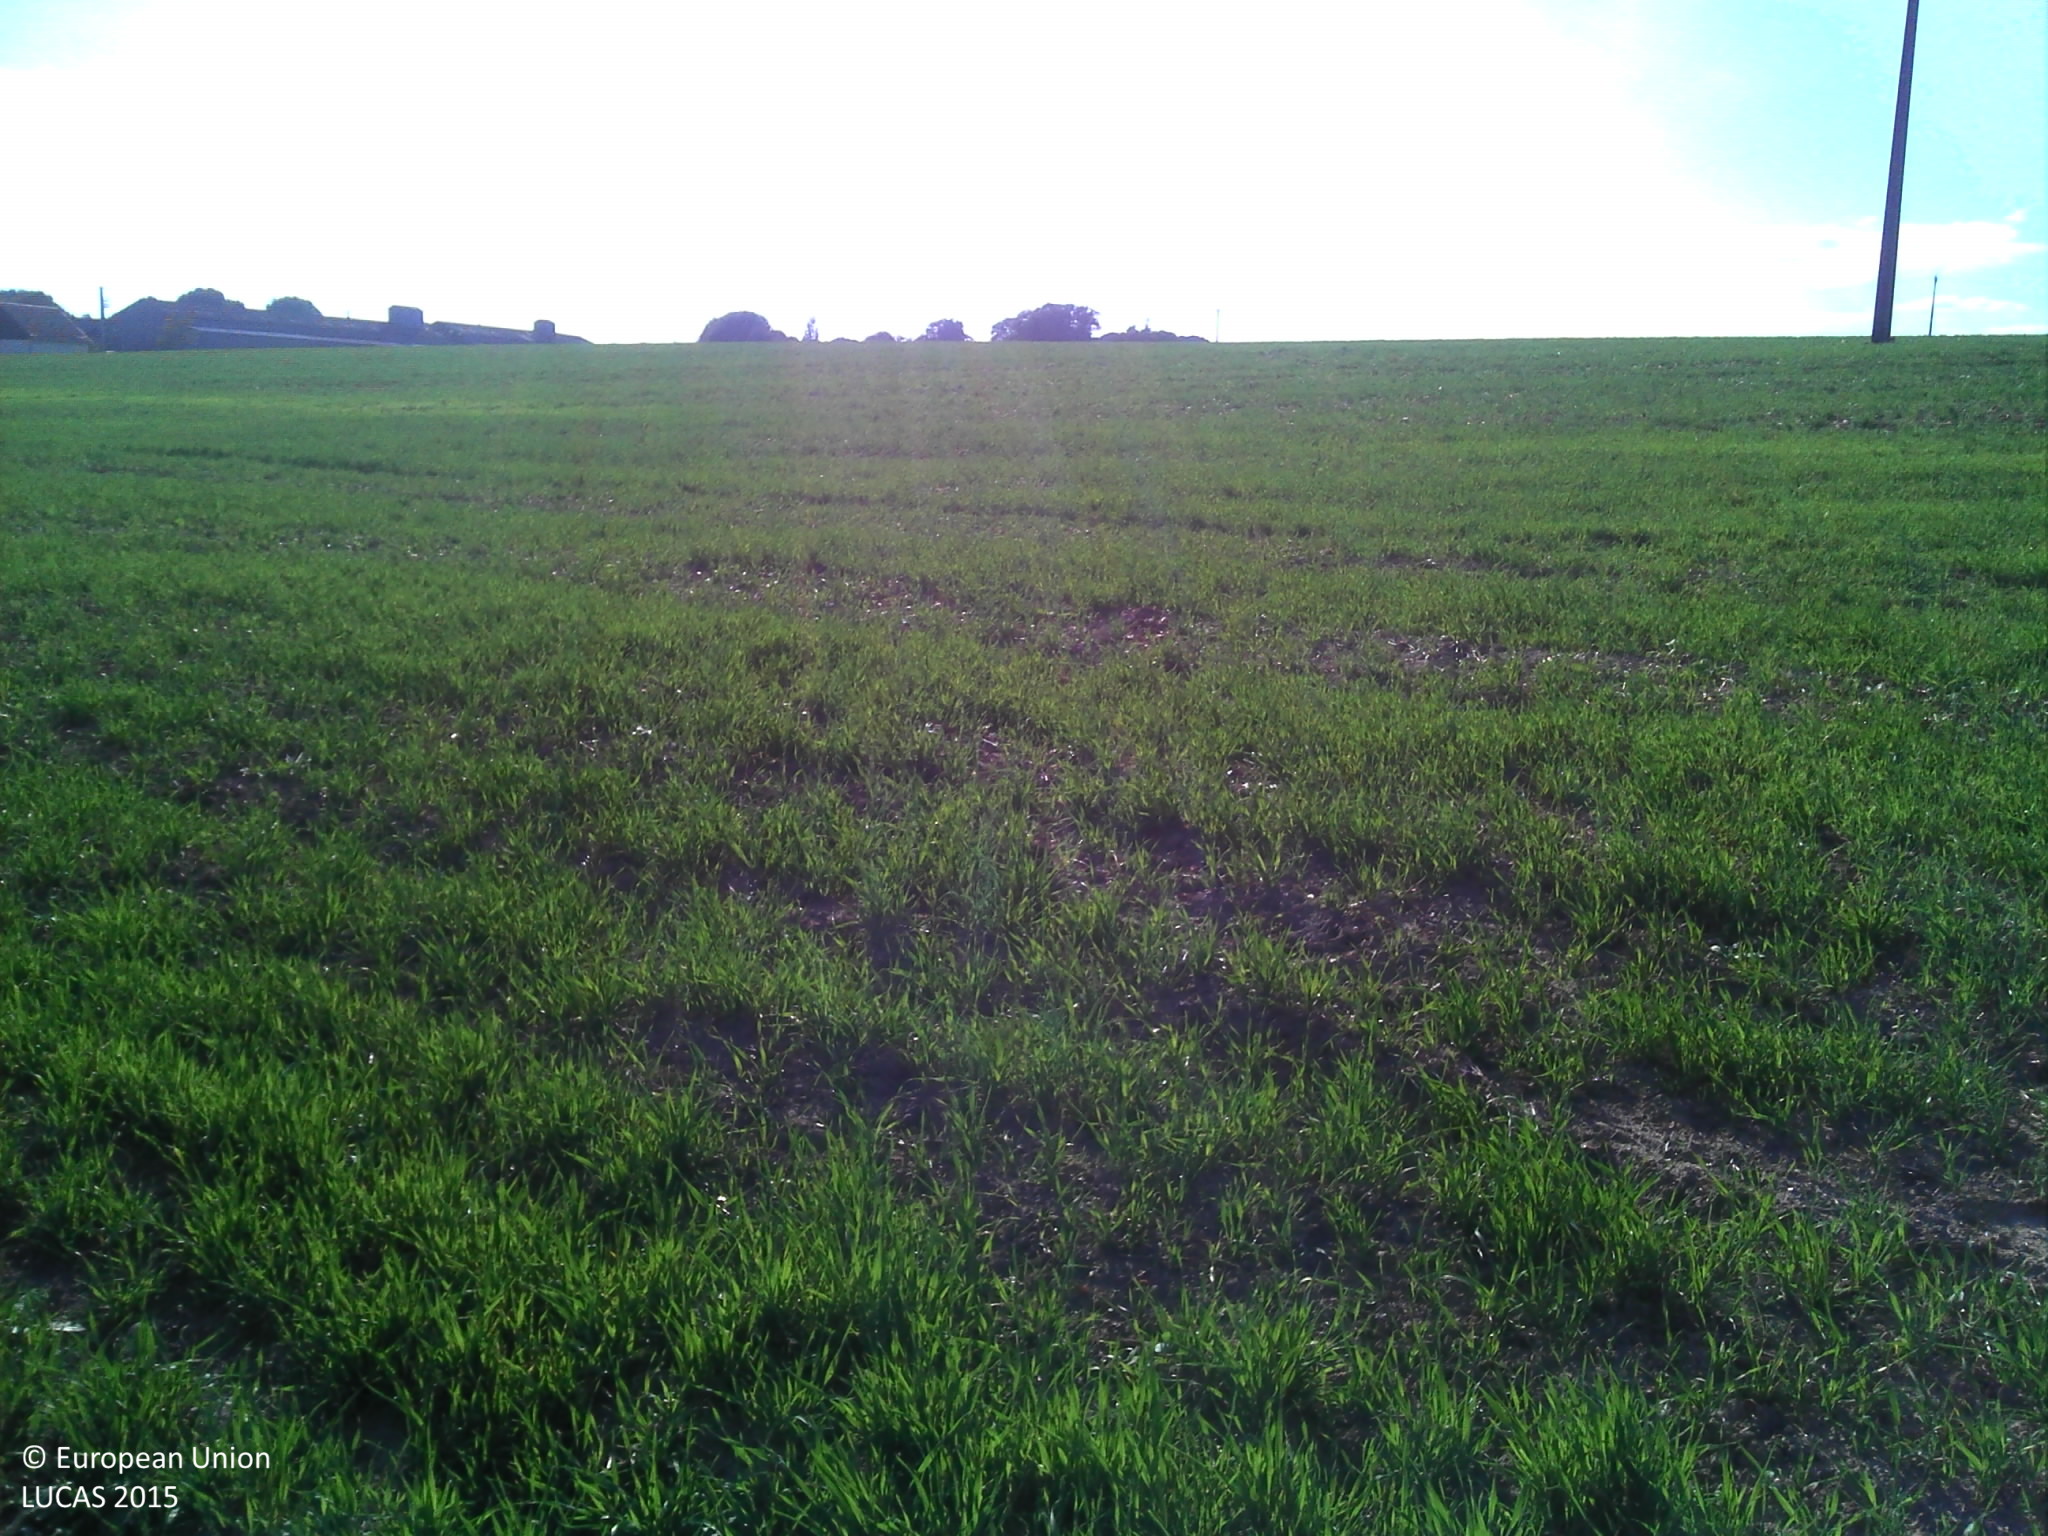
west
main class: Grassland
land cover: Grassland without tree/shrub cover
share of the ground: > 75 %
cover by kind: herbaceous plants 95 %, unconsolidated bare surface 5 %
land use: Agriculture (excluding fallow land and kitchen gardens)
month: September
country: FR
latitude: 47.0641
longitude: 1.5215
